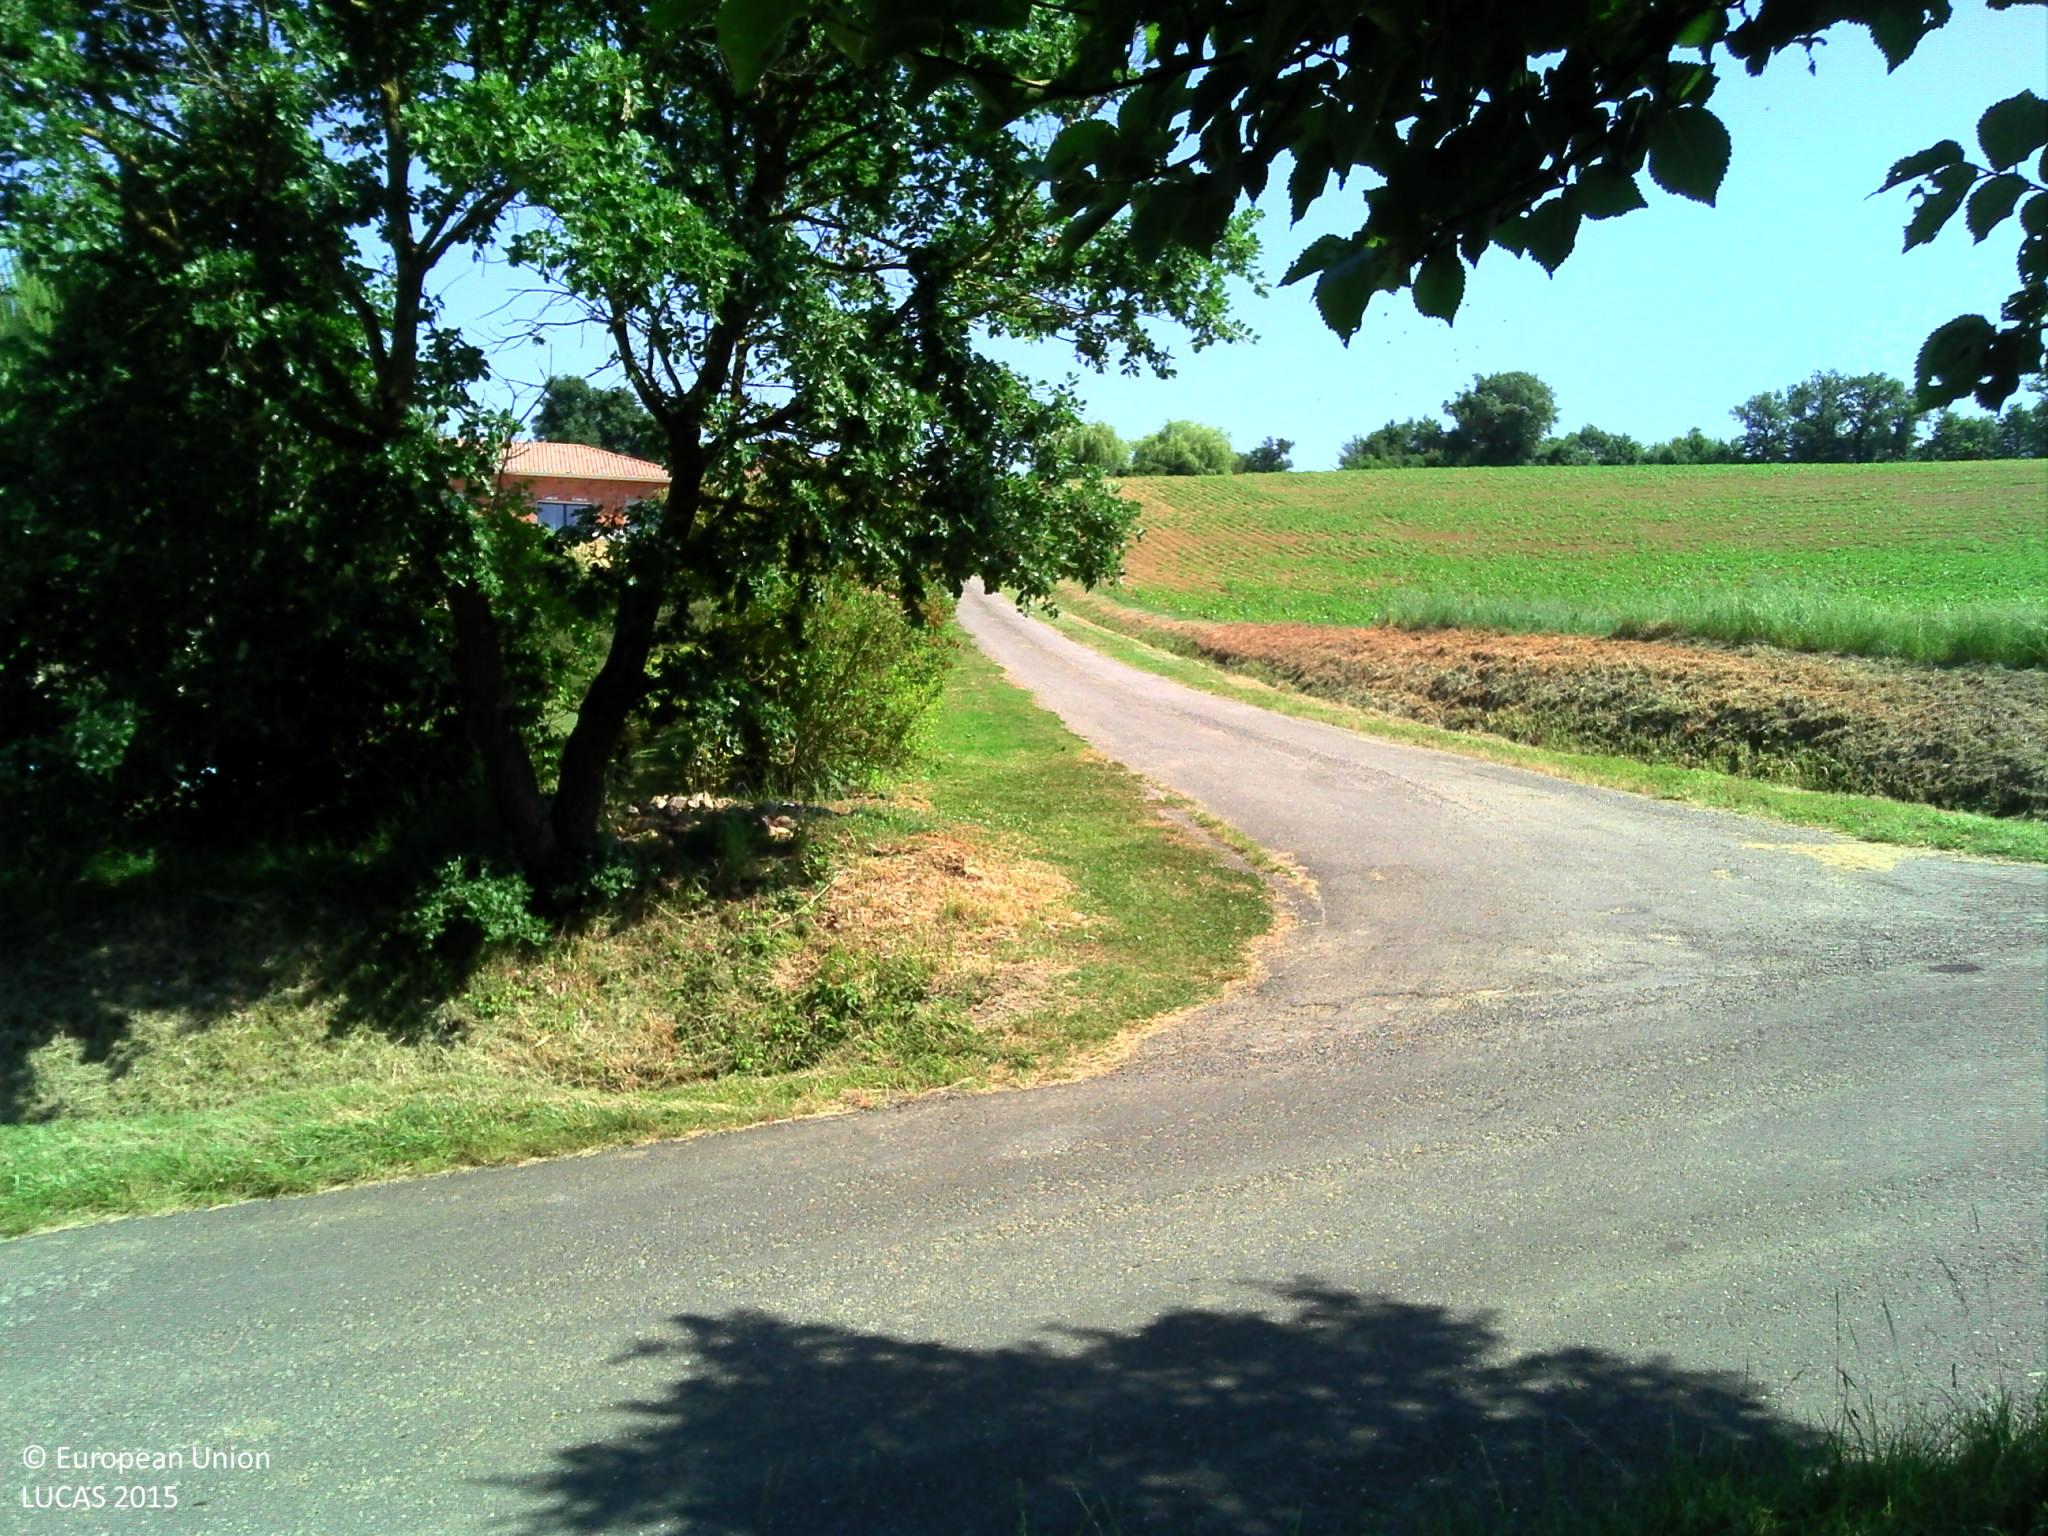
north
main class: Grassland
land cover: Grassland with sparse tree/shrub cover
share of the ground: > 75 %
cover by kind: herbaceous plants 95 %, broadleaved forest trees 5 %
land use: Residential
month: June
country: FR
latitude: 43.6586
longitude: 0.6858
